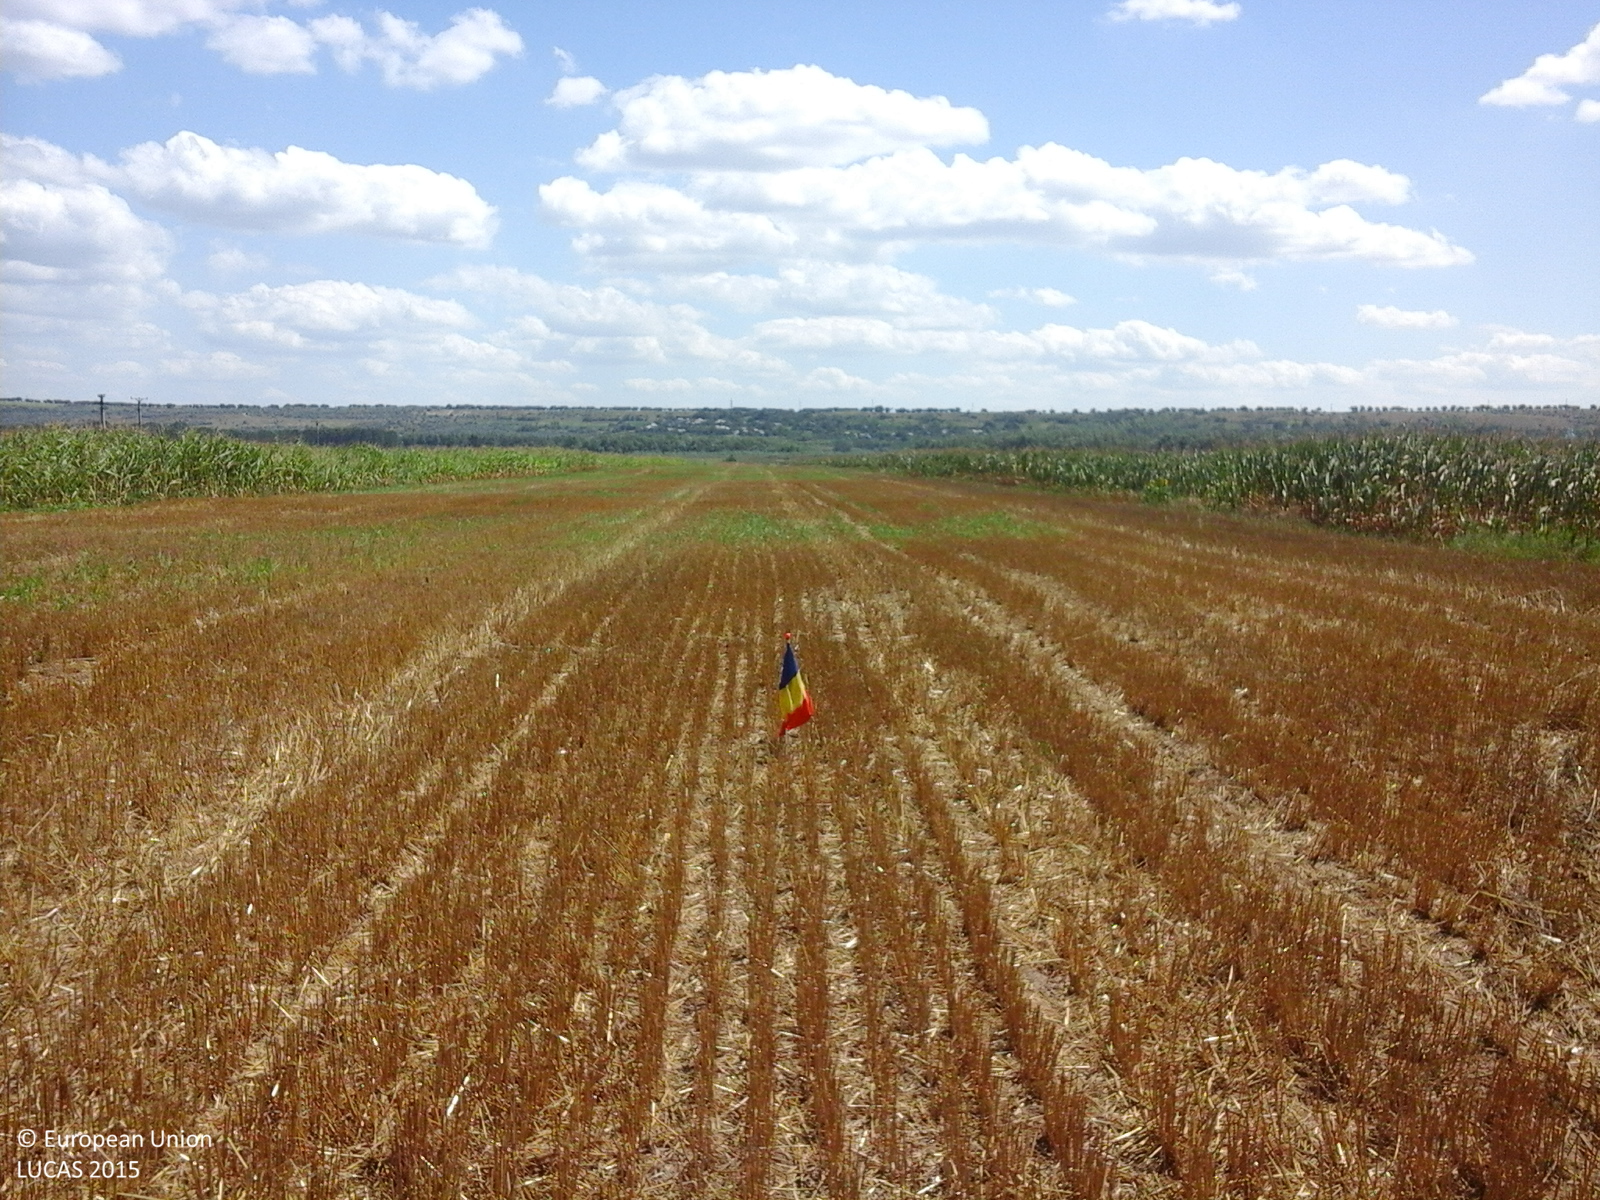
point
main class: Cropland
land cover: Common wheat
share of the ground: 50 - 75 %
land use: Agriculture (excluding fallow land and kitchen gardens)
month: July
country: RO
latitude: 46.4268
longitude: 28.2343
